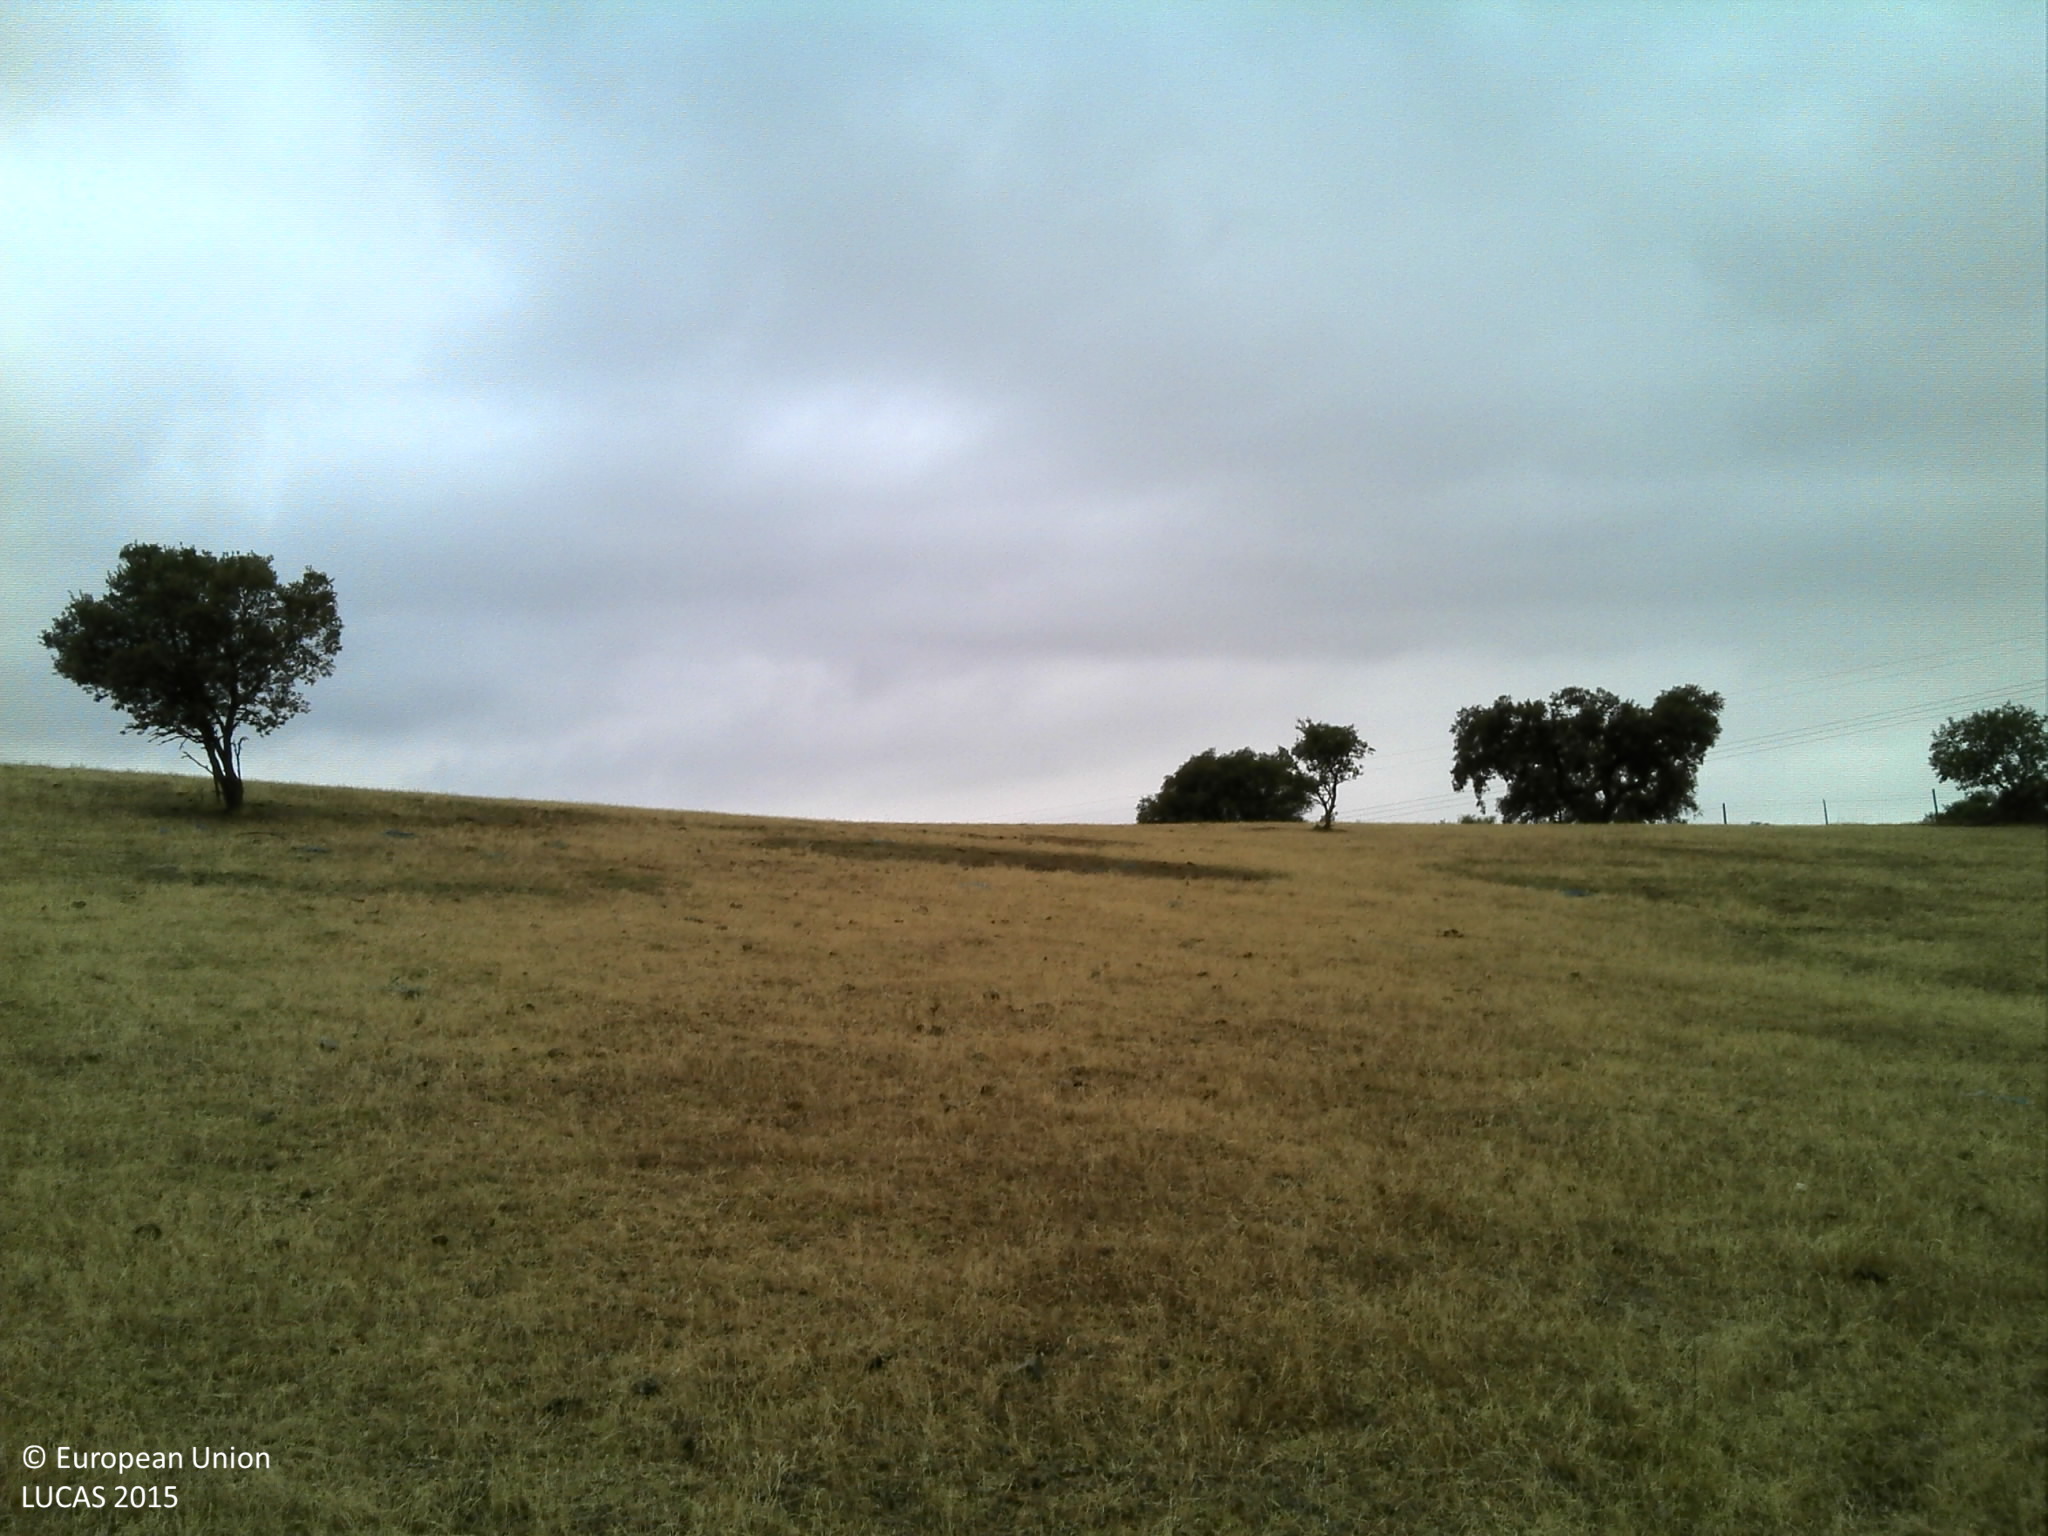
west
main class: Grassland
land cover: Spontaneously vegetated surfaces
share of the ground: 10 - 25 %
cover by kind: unconsolidated bare surface 75 %, herbaceous plants 25 %
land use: Agriculture (excluding fallow land and kitchen gardens)
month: June
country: PT
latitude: 38.3351
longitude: -7.9633
